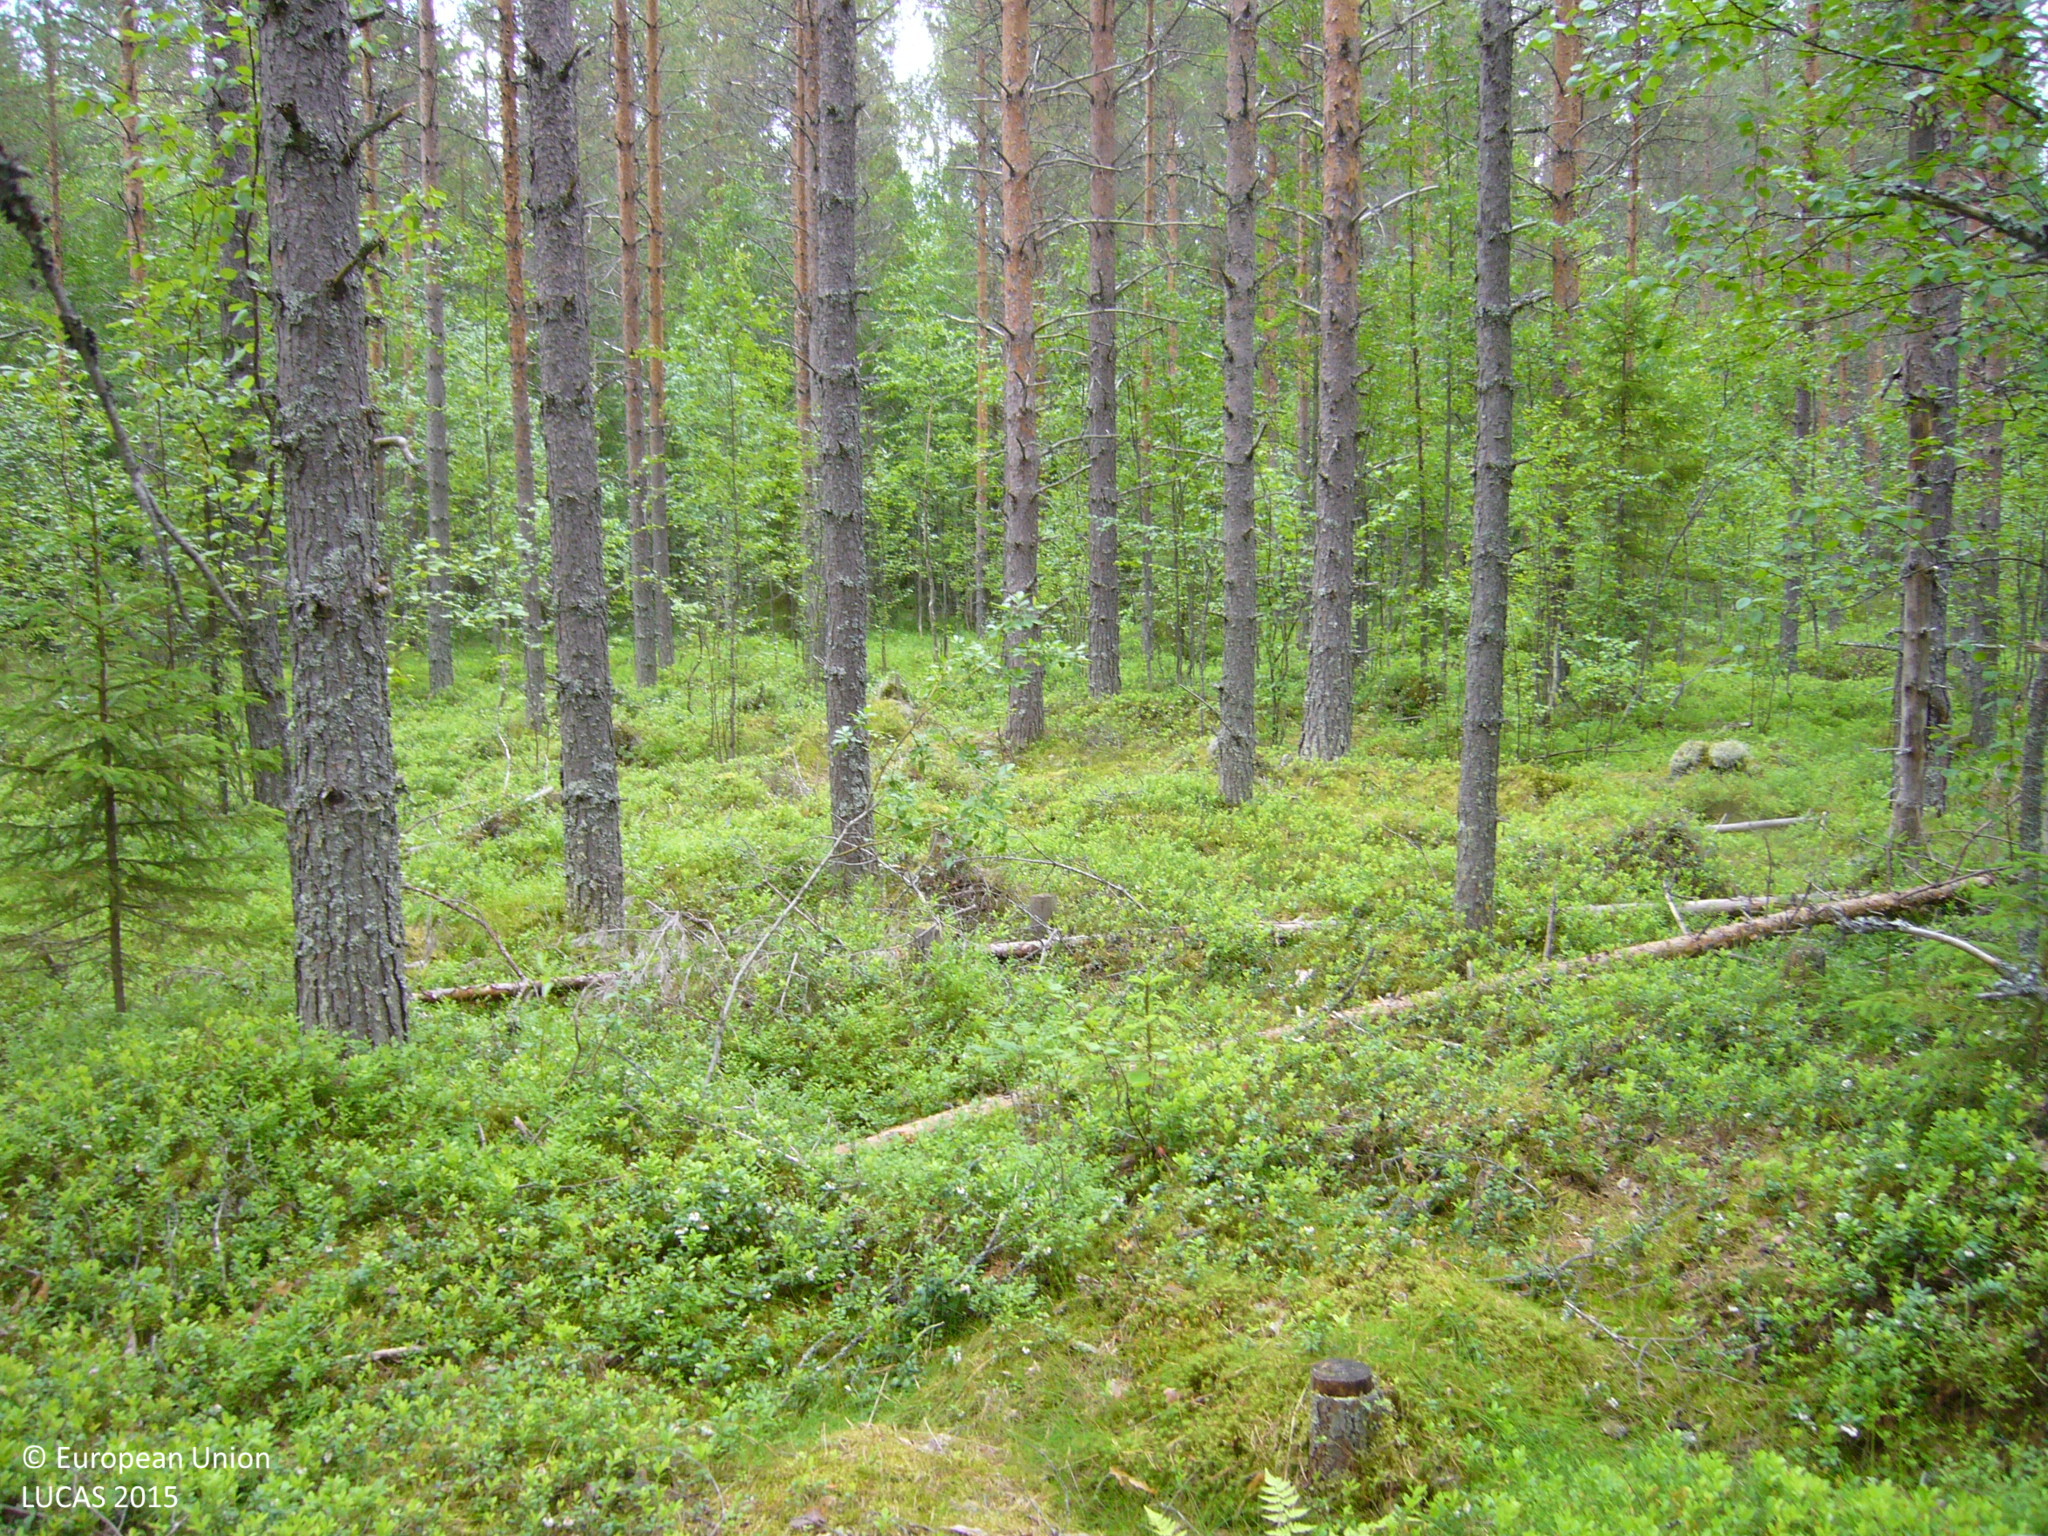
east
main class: Woodland
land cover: Pine dominated mixed woodland
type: boreal forest
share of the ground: 50 - 75 %
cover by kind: coniferous forest trees 50 %, shrubs 30 %, broadleaved forest trees 20 %
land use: Forestry
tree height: > 5 m
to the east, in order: Pine dominated mixed woodland; Ditches and canals; Spruce dominated mixed woodland; Pine dominated mixed woodland; Pine dominated coniferous woodland
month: July
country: FI
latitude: 63.3126
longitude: 26.0631
